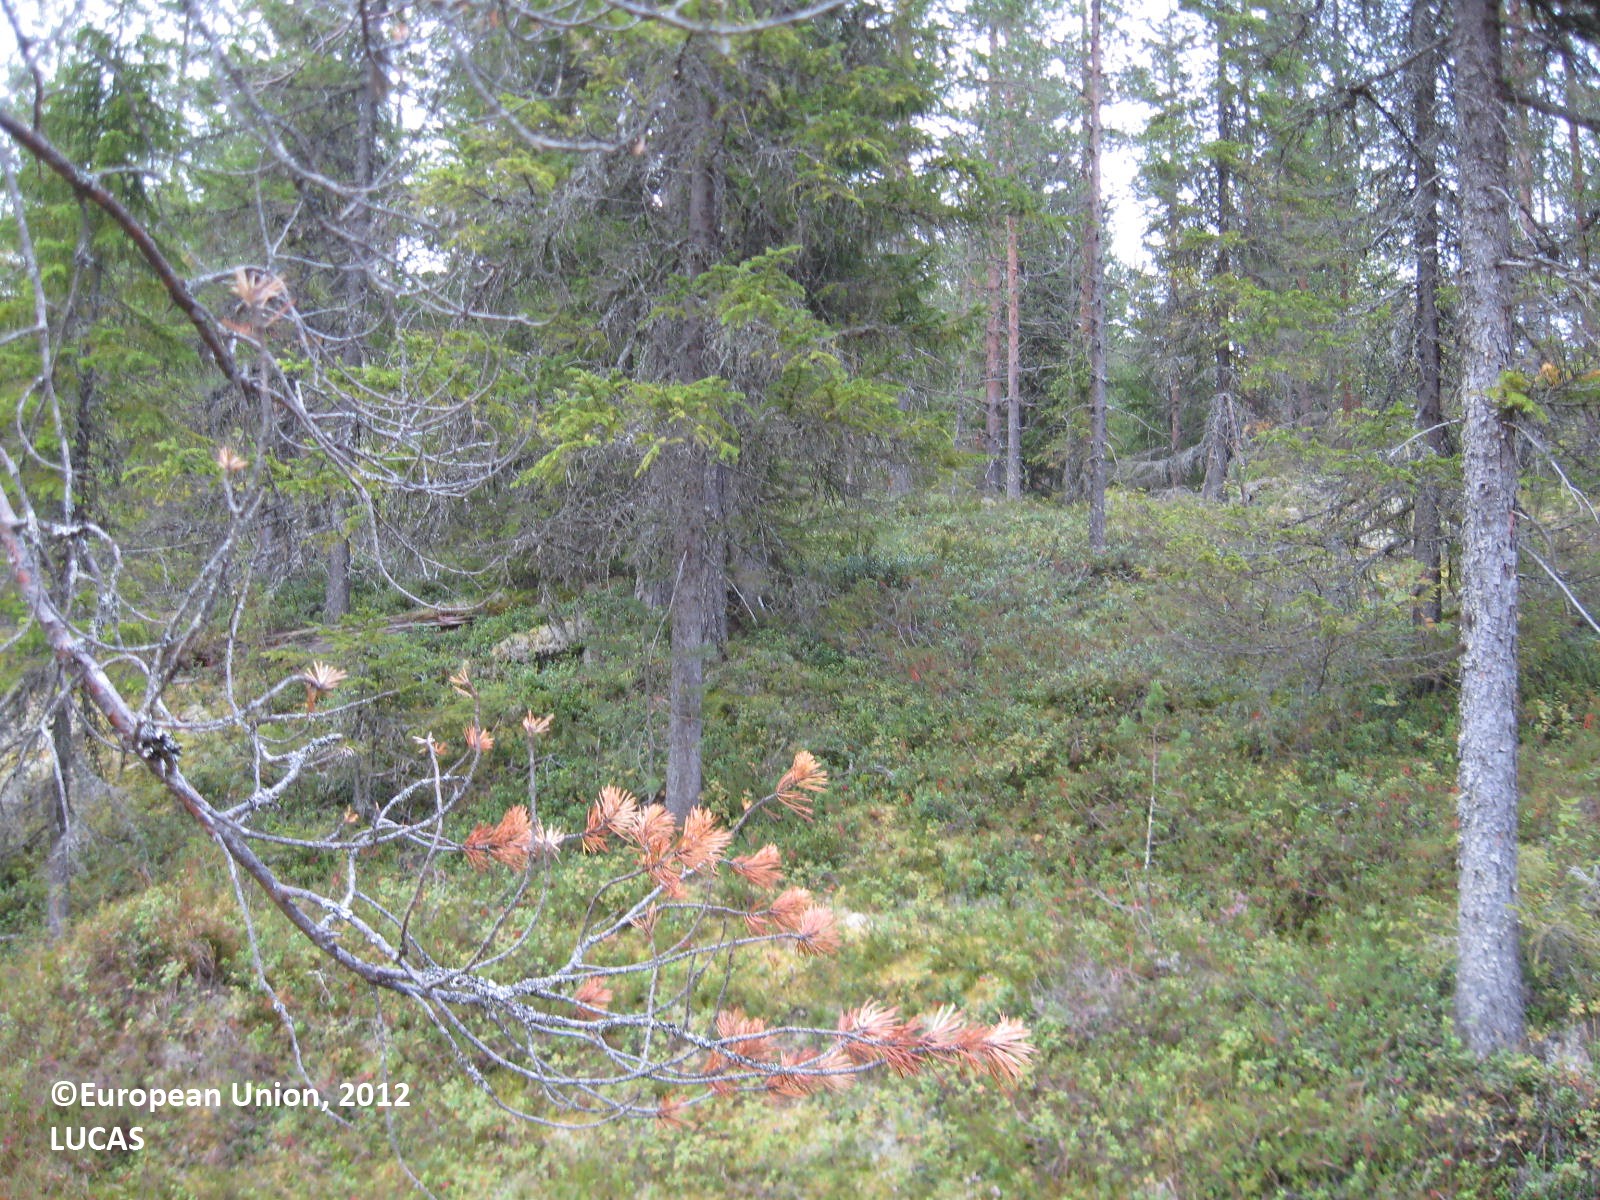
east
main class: Woodland
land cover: Pine dominated coniferous woodland
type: boreal forest
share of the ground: 50 - 75 %
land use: Semi-natural and natural areas not in use
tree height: > 5 m
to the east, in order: Pine dominated coniferous woodland; Other coniferous woodland; Ditches and canals; Other coniferous woodland
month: August
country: FI
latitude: 63.7242
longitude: 29.6888
